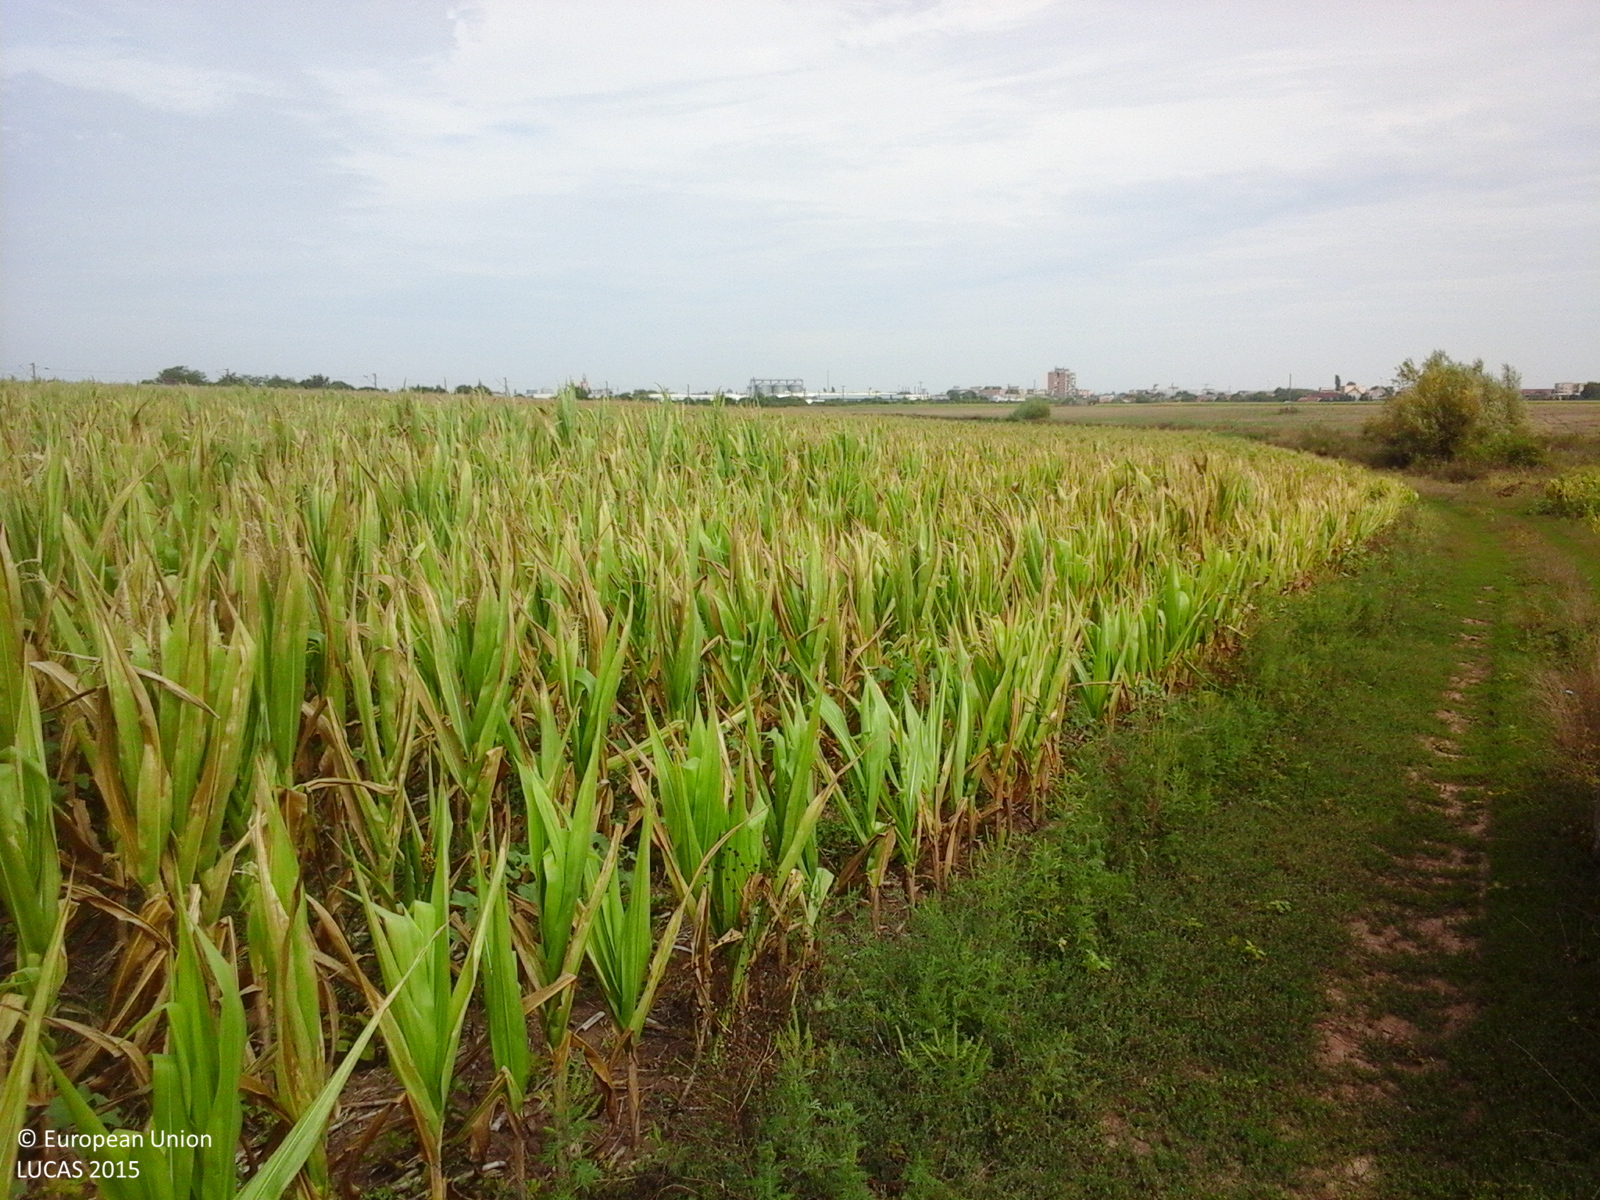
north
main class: Cropland
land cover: Maize
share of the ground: > 75 %
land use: Agriculture (excluding fallow land and kitchen gardens)
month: August
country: RO
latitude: 46.1286
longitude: 21.3326
